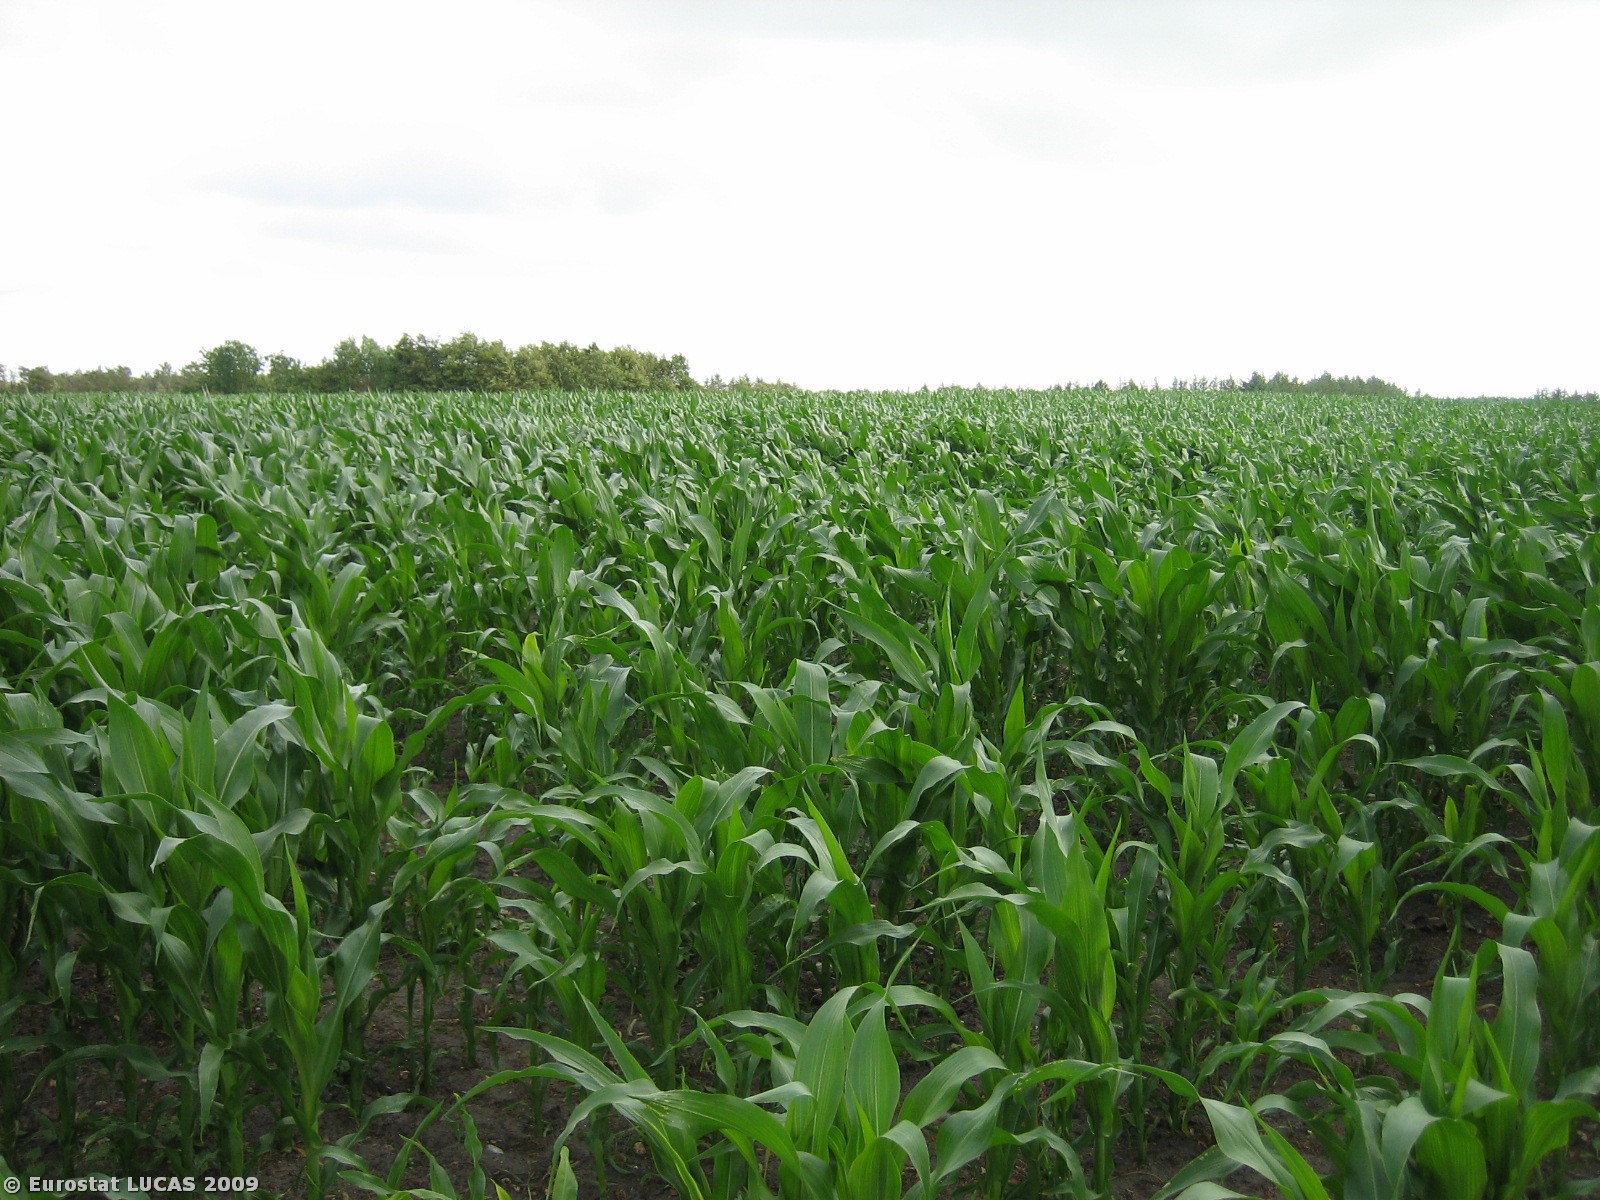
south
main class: Cropland
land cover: Barley
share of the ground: 25 - 50 %
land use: Agriculture (excluding fallow land and kitchen gardens)
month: July
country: DK
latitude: 55.7107
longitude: 8.4258
